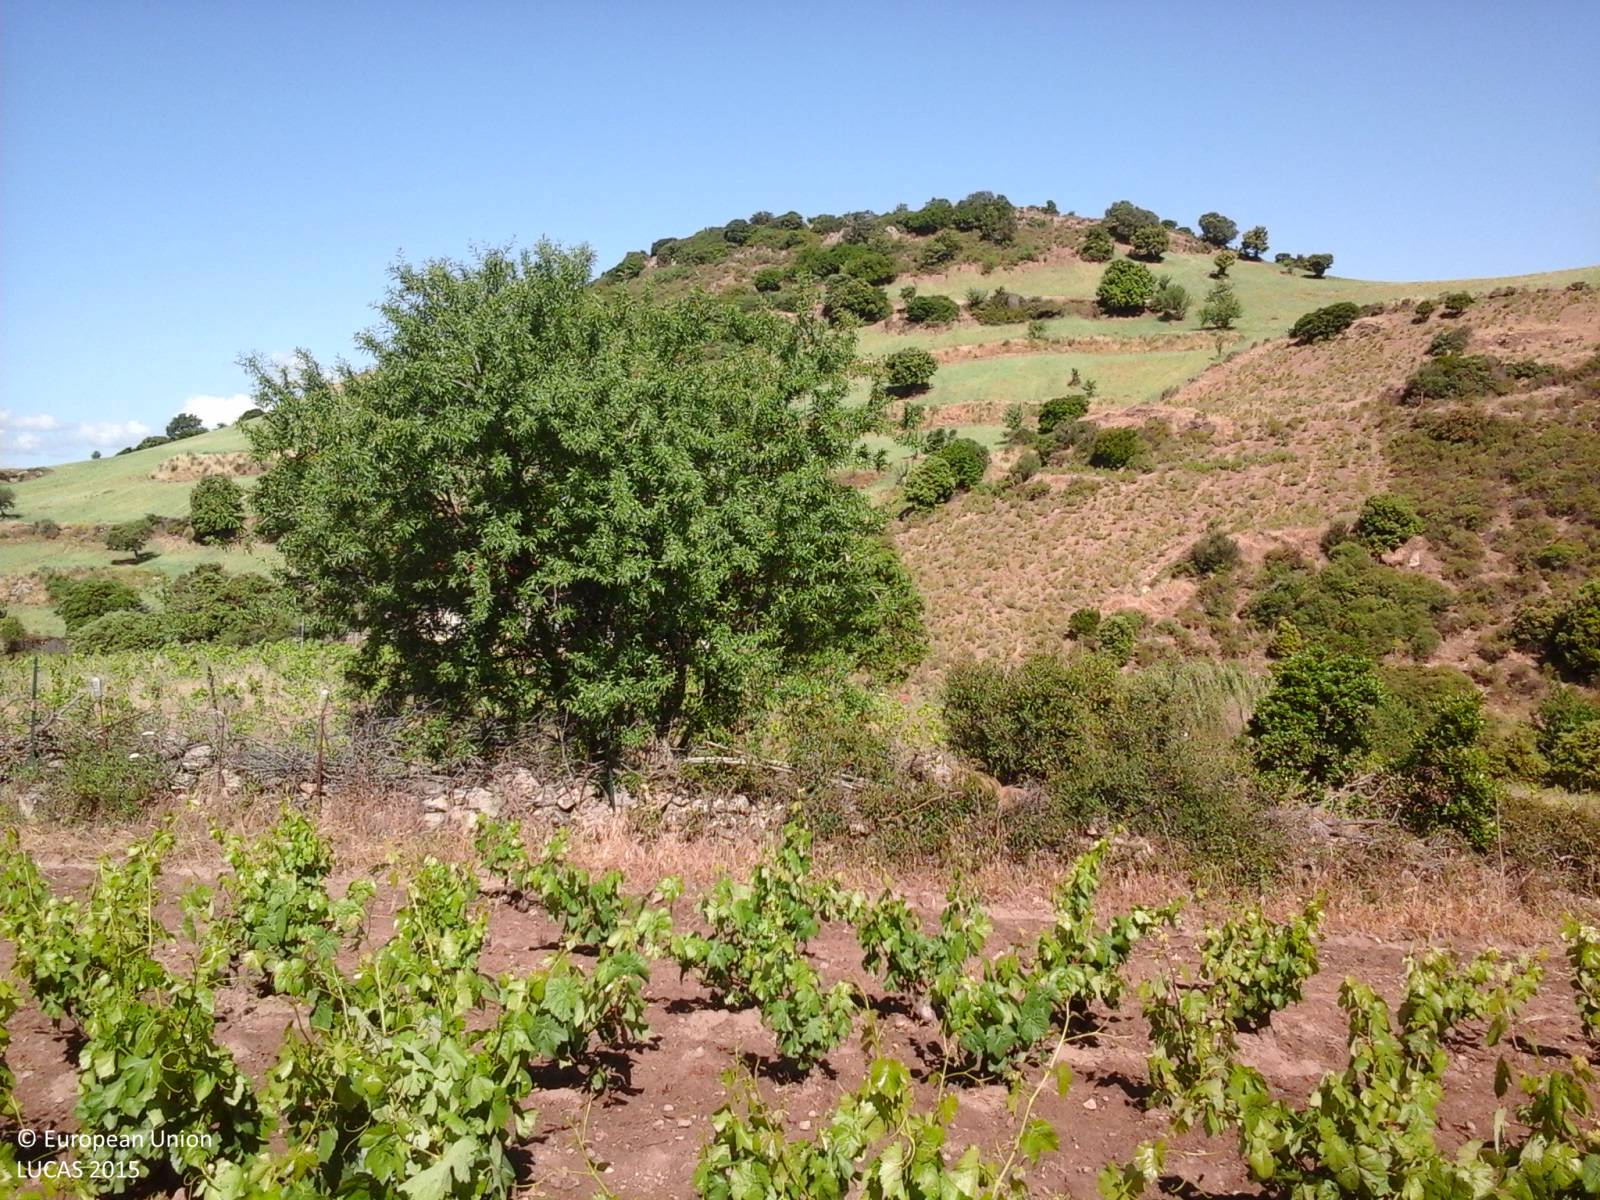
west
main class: Cropland
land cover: Vineyards
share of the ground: 50 - 75 %
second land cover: Other bare soil
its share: > 75 %
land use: Agriculture (excluding fallow land and kitchen gardens)
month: May
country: IT
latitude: 40.2293
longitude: 9.4038
